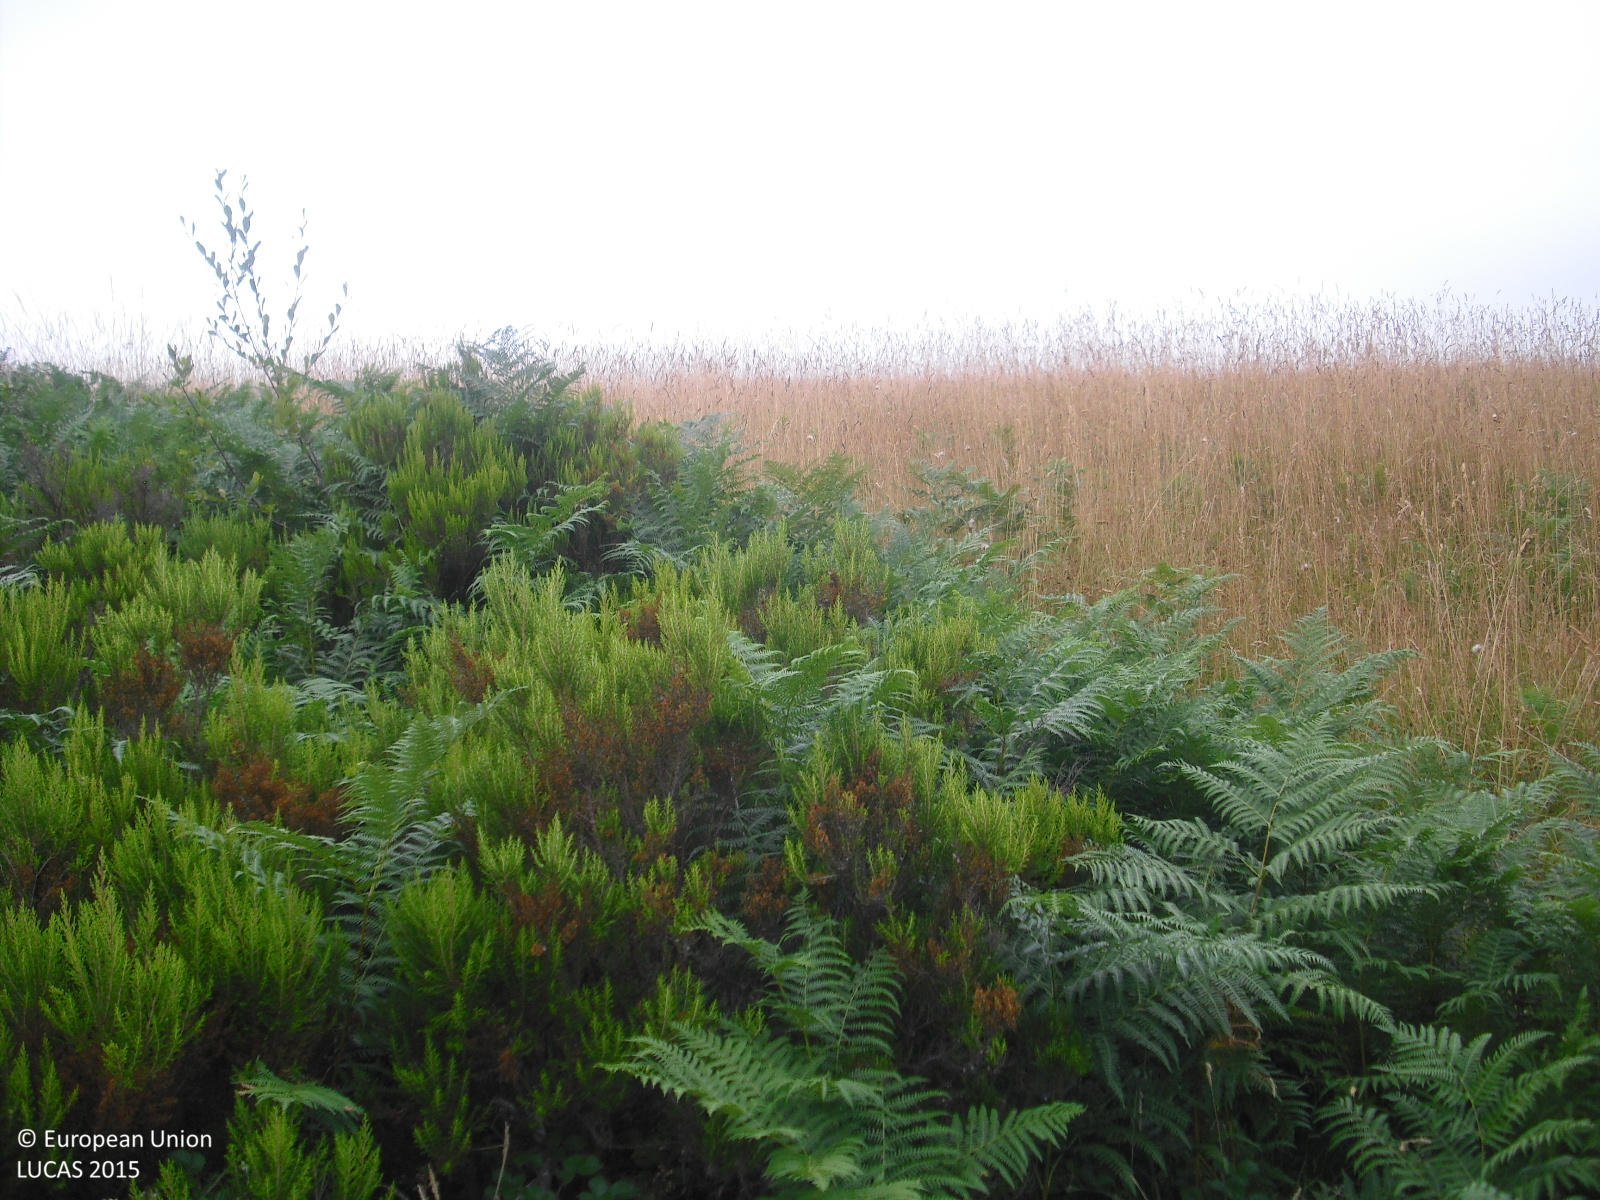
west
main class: Shrubland
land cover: Shrubland without tree cover
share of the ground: > 75 %
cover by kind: shrubs 100 %
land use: Agriculture (excluding fallow land and kitchen gardens)
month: July
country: ES
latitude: 42.7095
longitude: -7.2435
